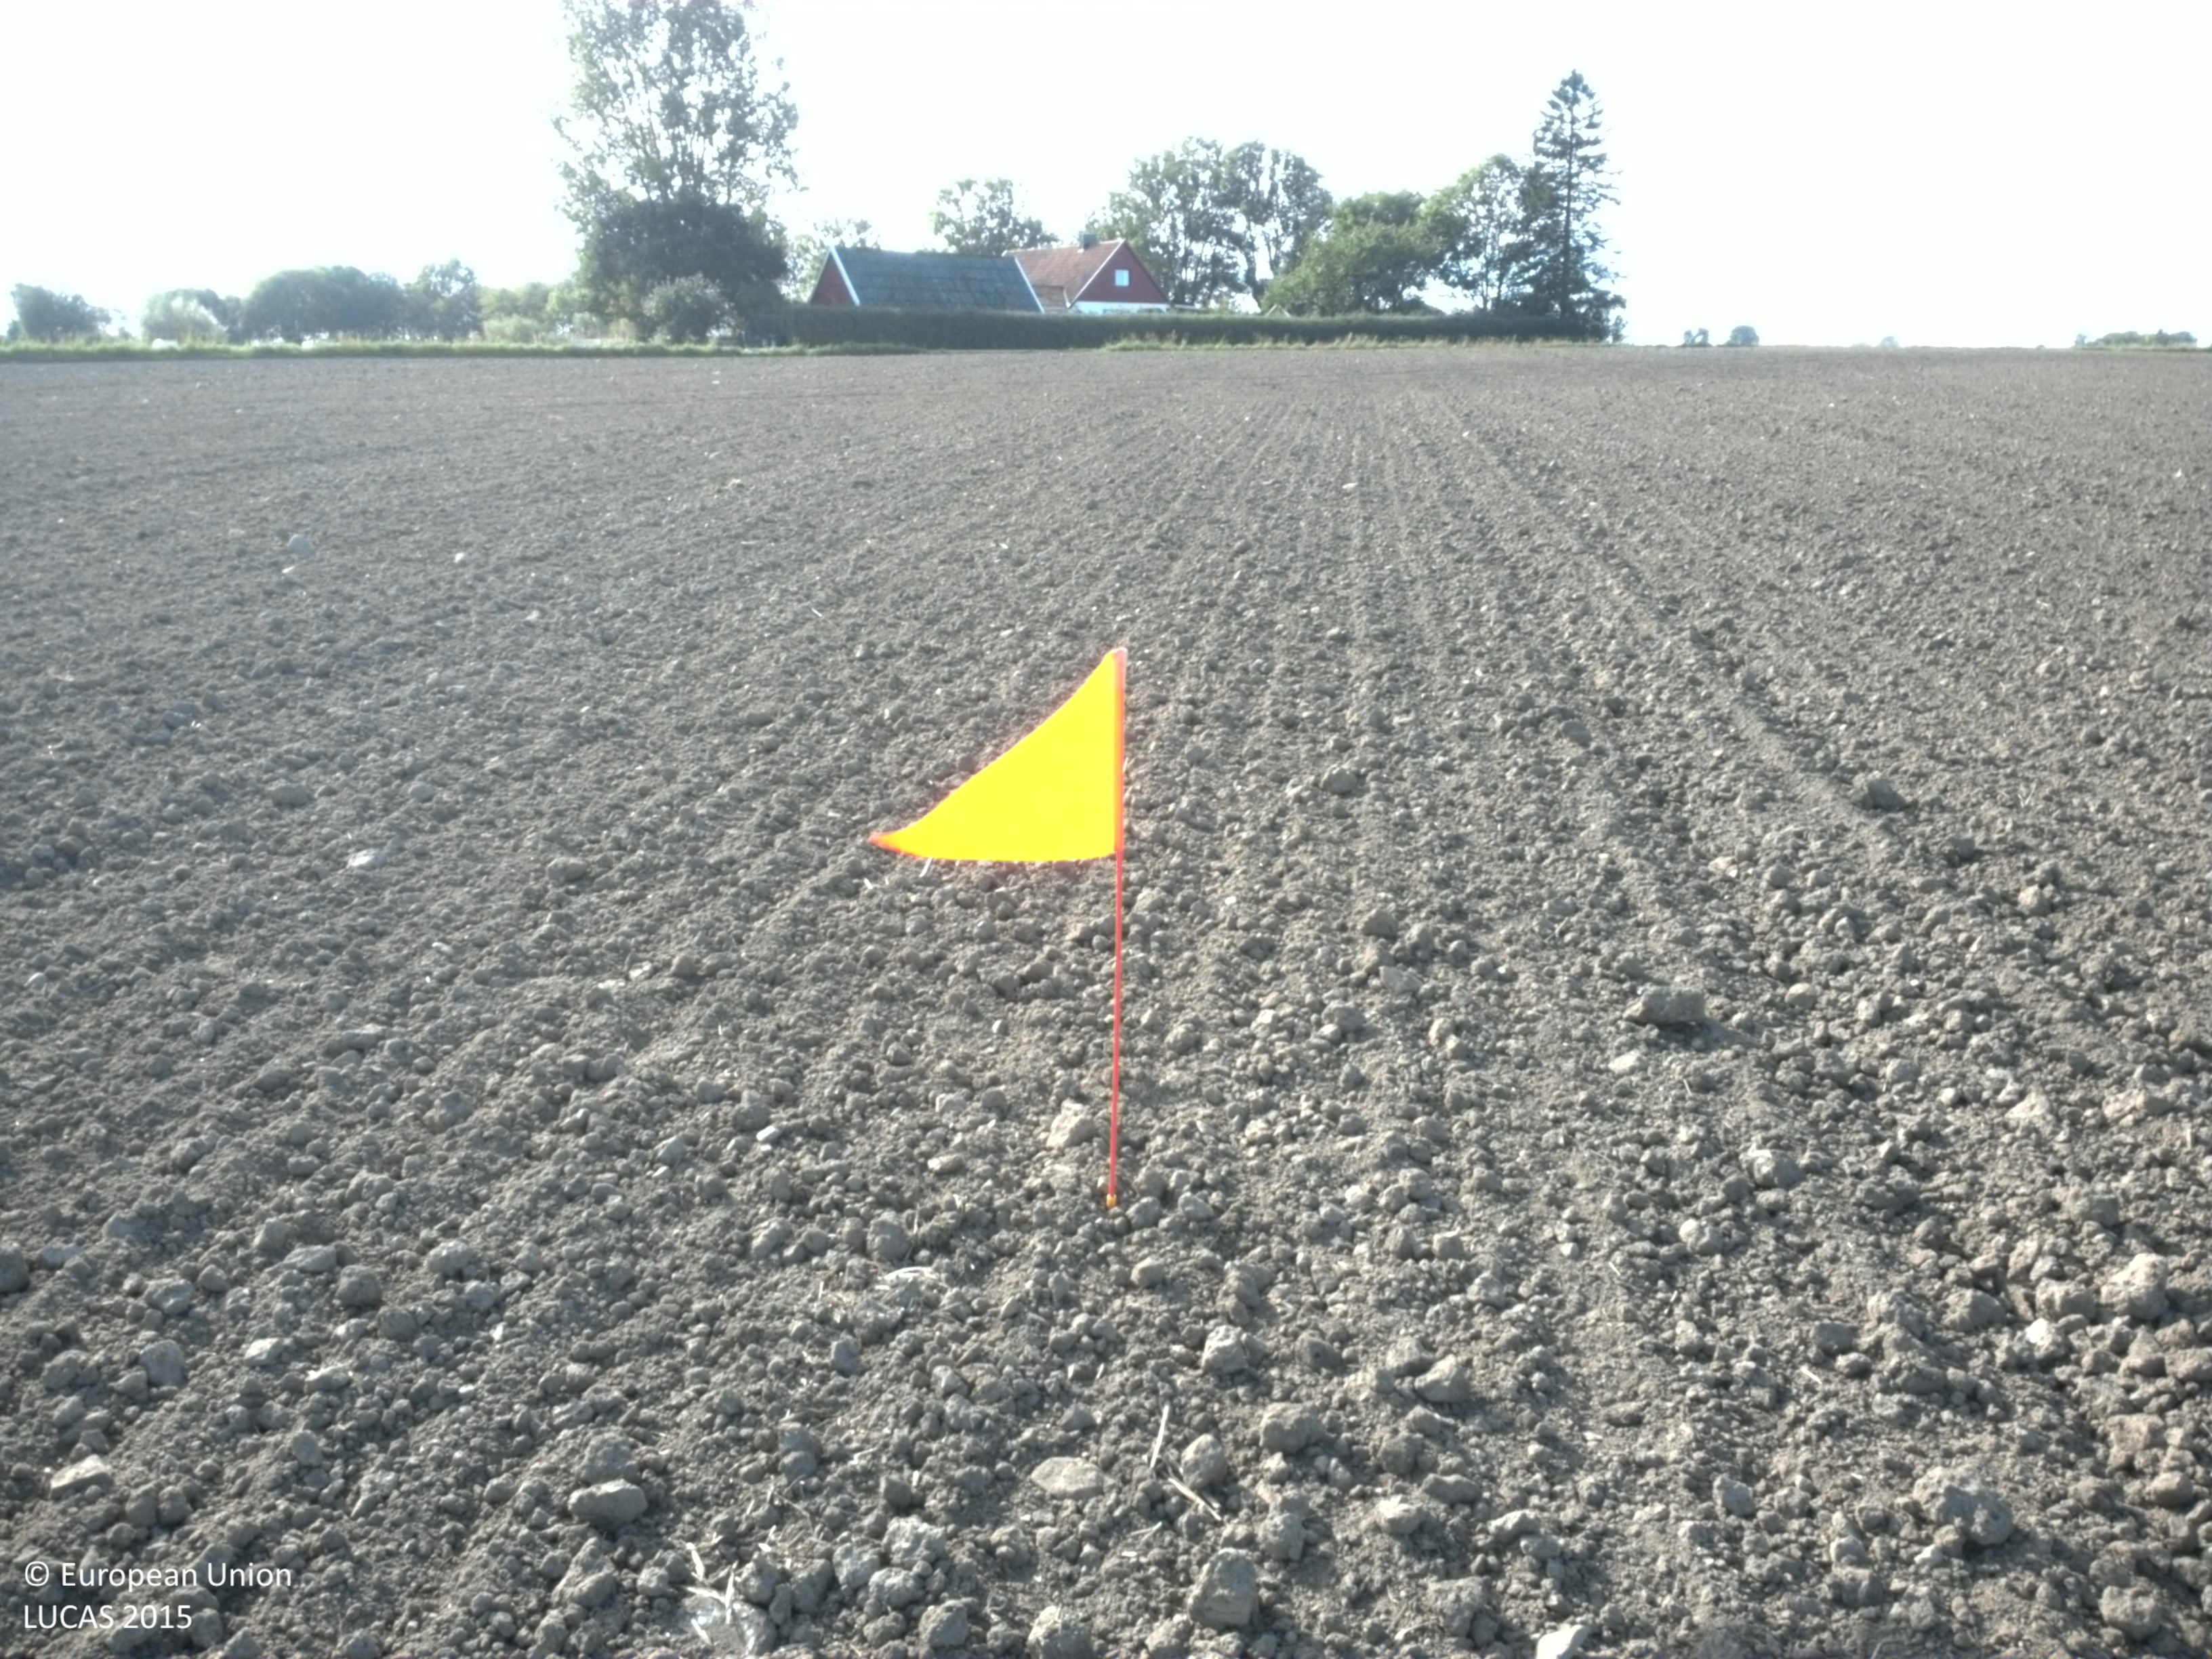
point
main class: Cropland
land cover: Common wheat
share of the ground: < 10 %
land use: Agriculture (excluding fallow land and kitchen gardens)
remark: Tilled/Sowed
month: October
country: SE
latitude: 55.7024
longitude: 13.7057
